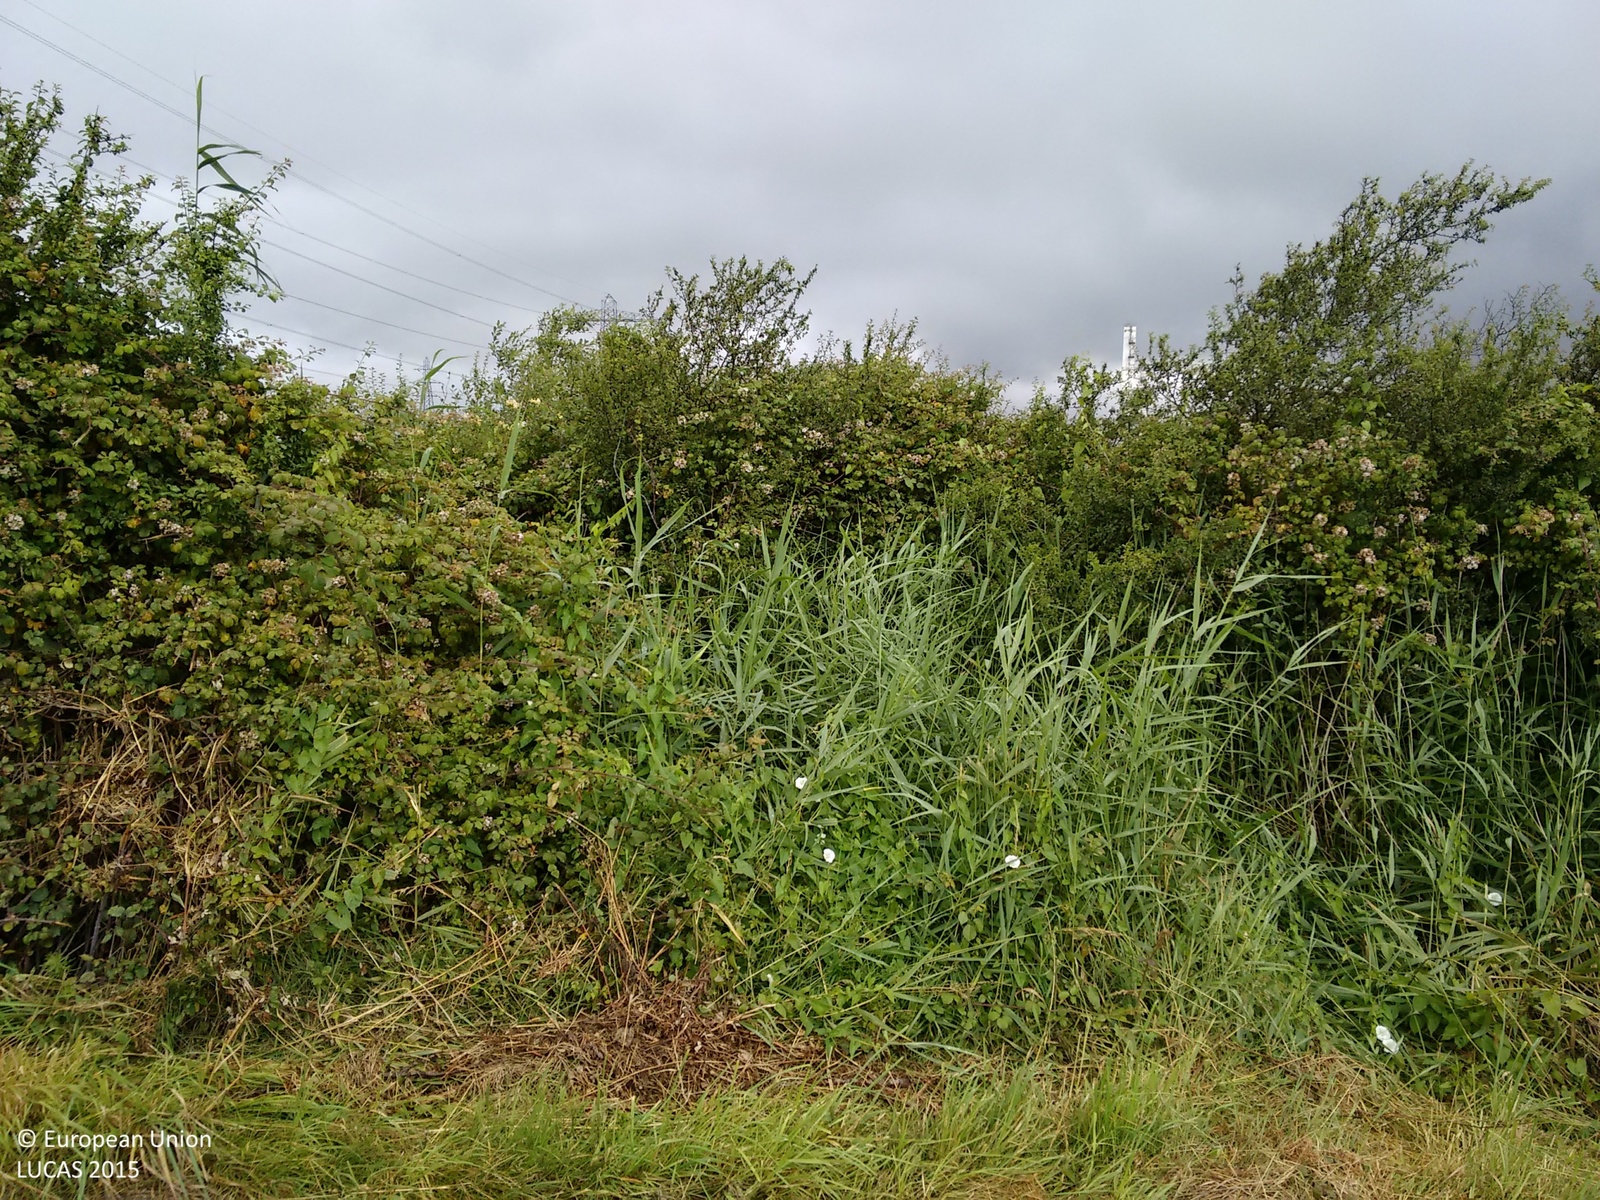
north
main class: Shrubland
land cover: Shrubland with sparse tree cover
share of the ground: > 75 %
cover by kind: shrubs 65 %, herbaceous plants 30 %, broadleaved forest trees 5 %
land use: Semi-natural and natural areas not in use
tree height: < 5 m
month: July
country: GB
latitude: 51.5543
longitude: -3.7476
